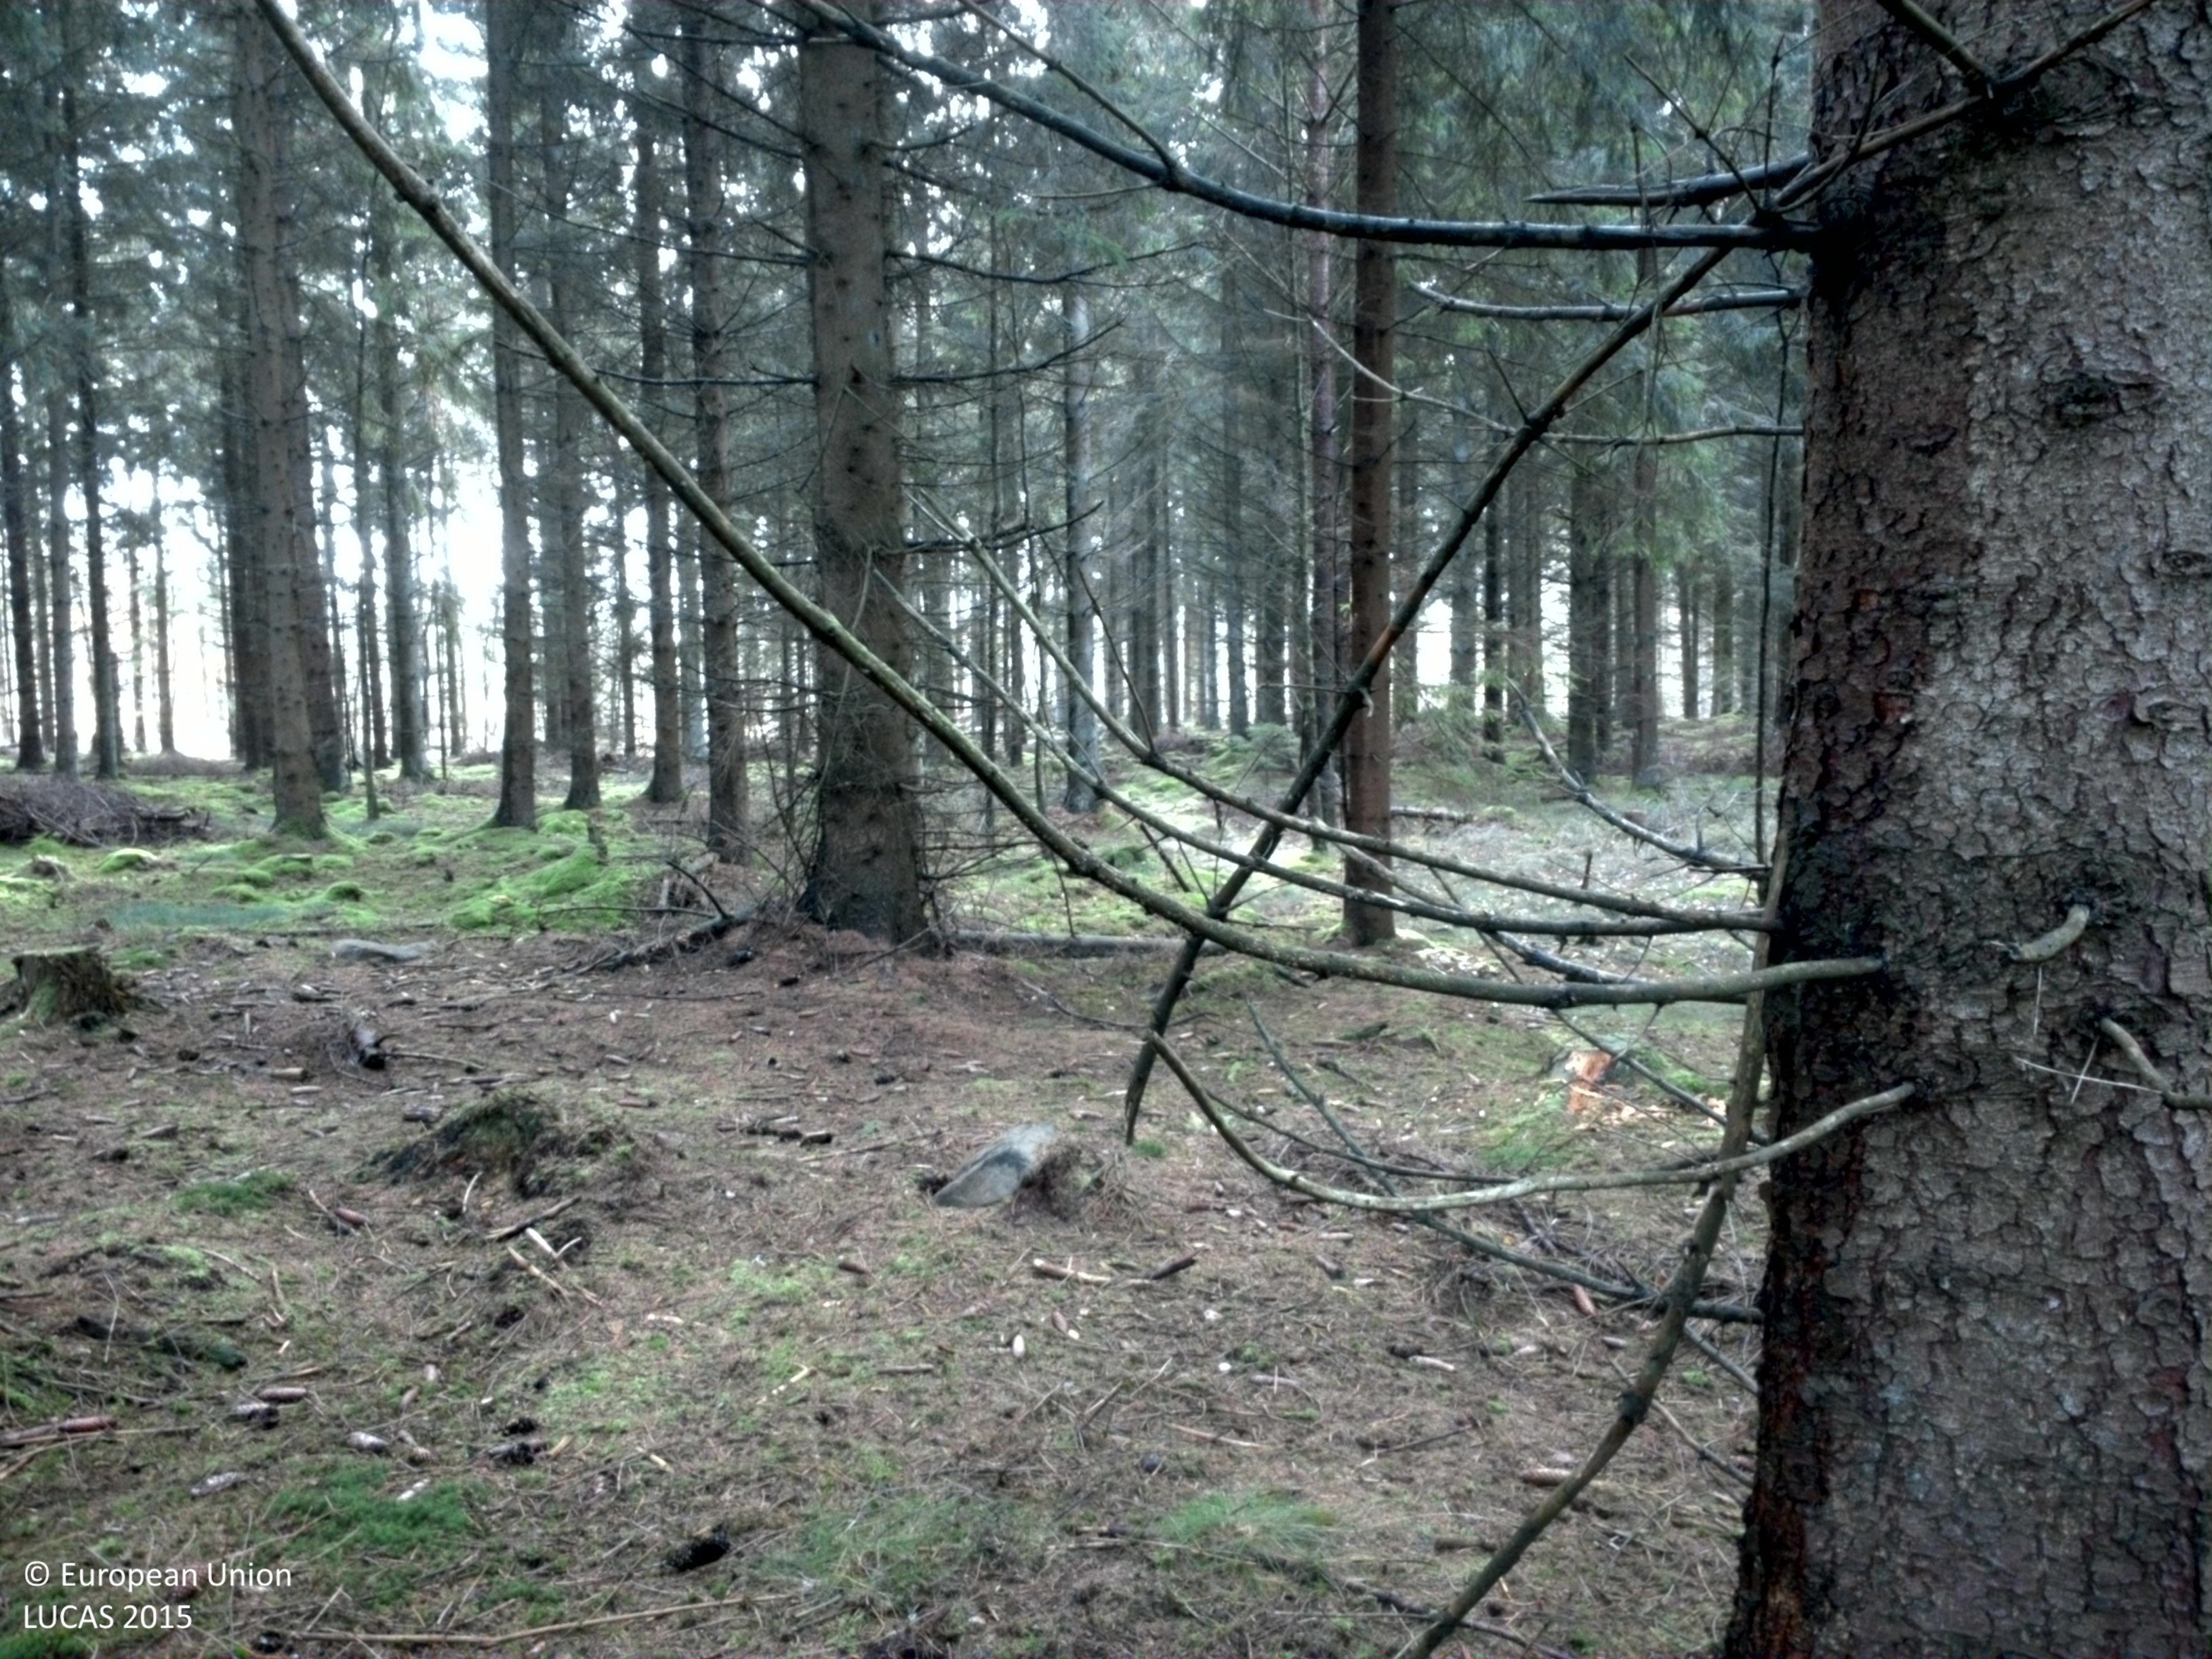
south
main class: Woodland
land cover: Spruce dominated coniferous woodland
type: hemiboreal forest and nemoral coniferous forest and mixed broadleaved-coniferous forest
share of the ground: > 75 %
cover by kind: coniferous forest trees 75 %, lichens and mosses 15 %, herbaceous plants 10 %
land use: Forestry
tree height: > 5 m
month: November
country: SE
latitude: 56.1487
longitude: 13.1685
